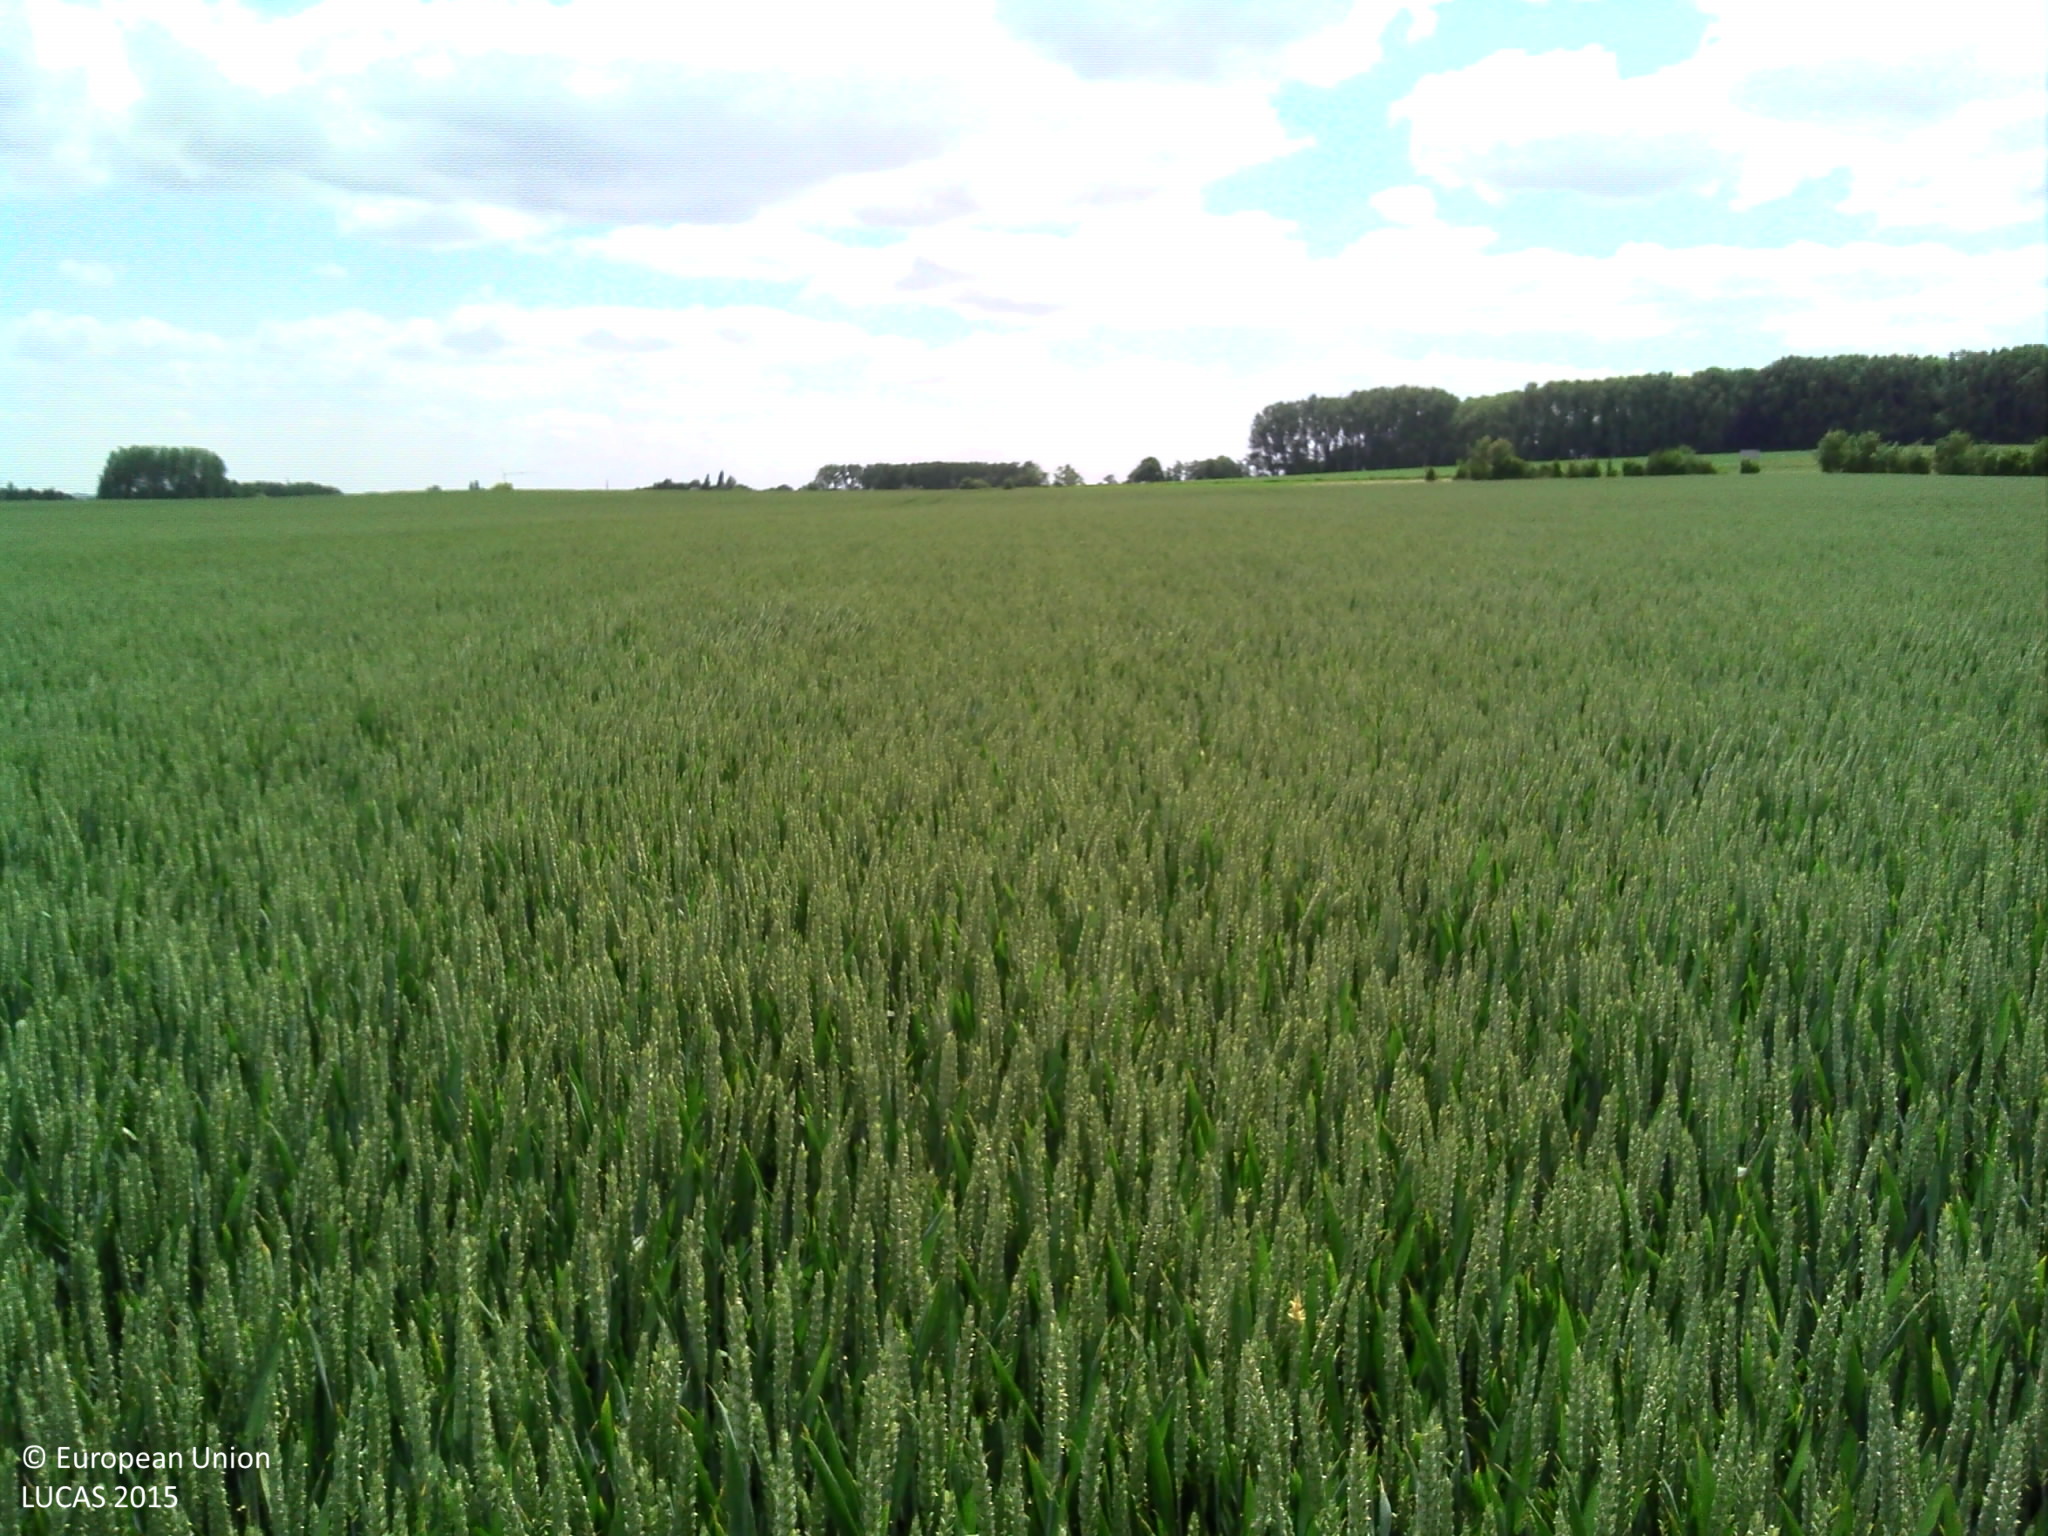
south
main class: Cropland
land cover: Common wheat
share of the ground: > 75 %
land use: Agriculture (excluding fallow land and kitchen gardens)
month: June
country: BE
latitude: 50.9067
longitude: 3.6073
